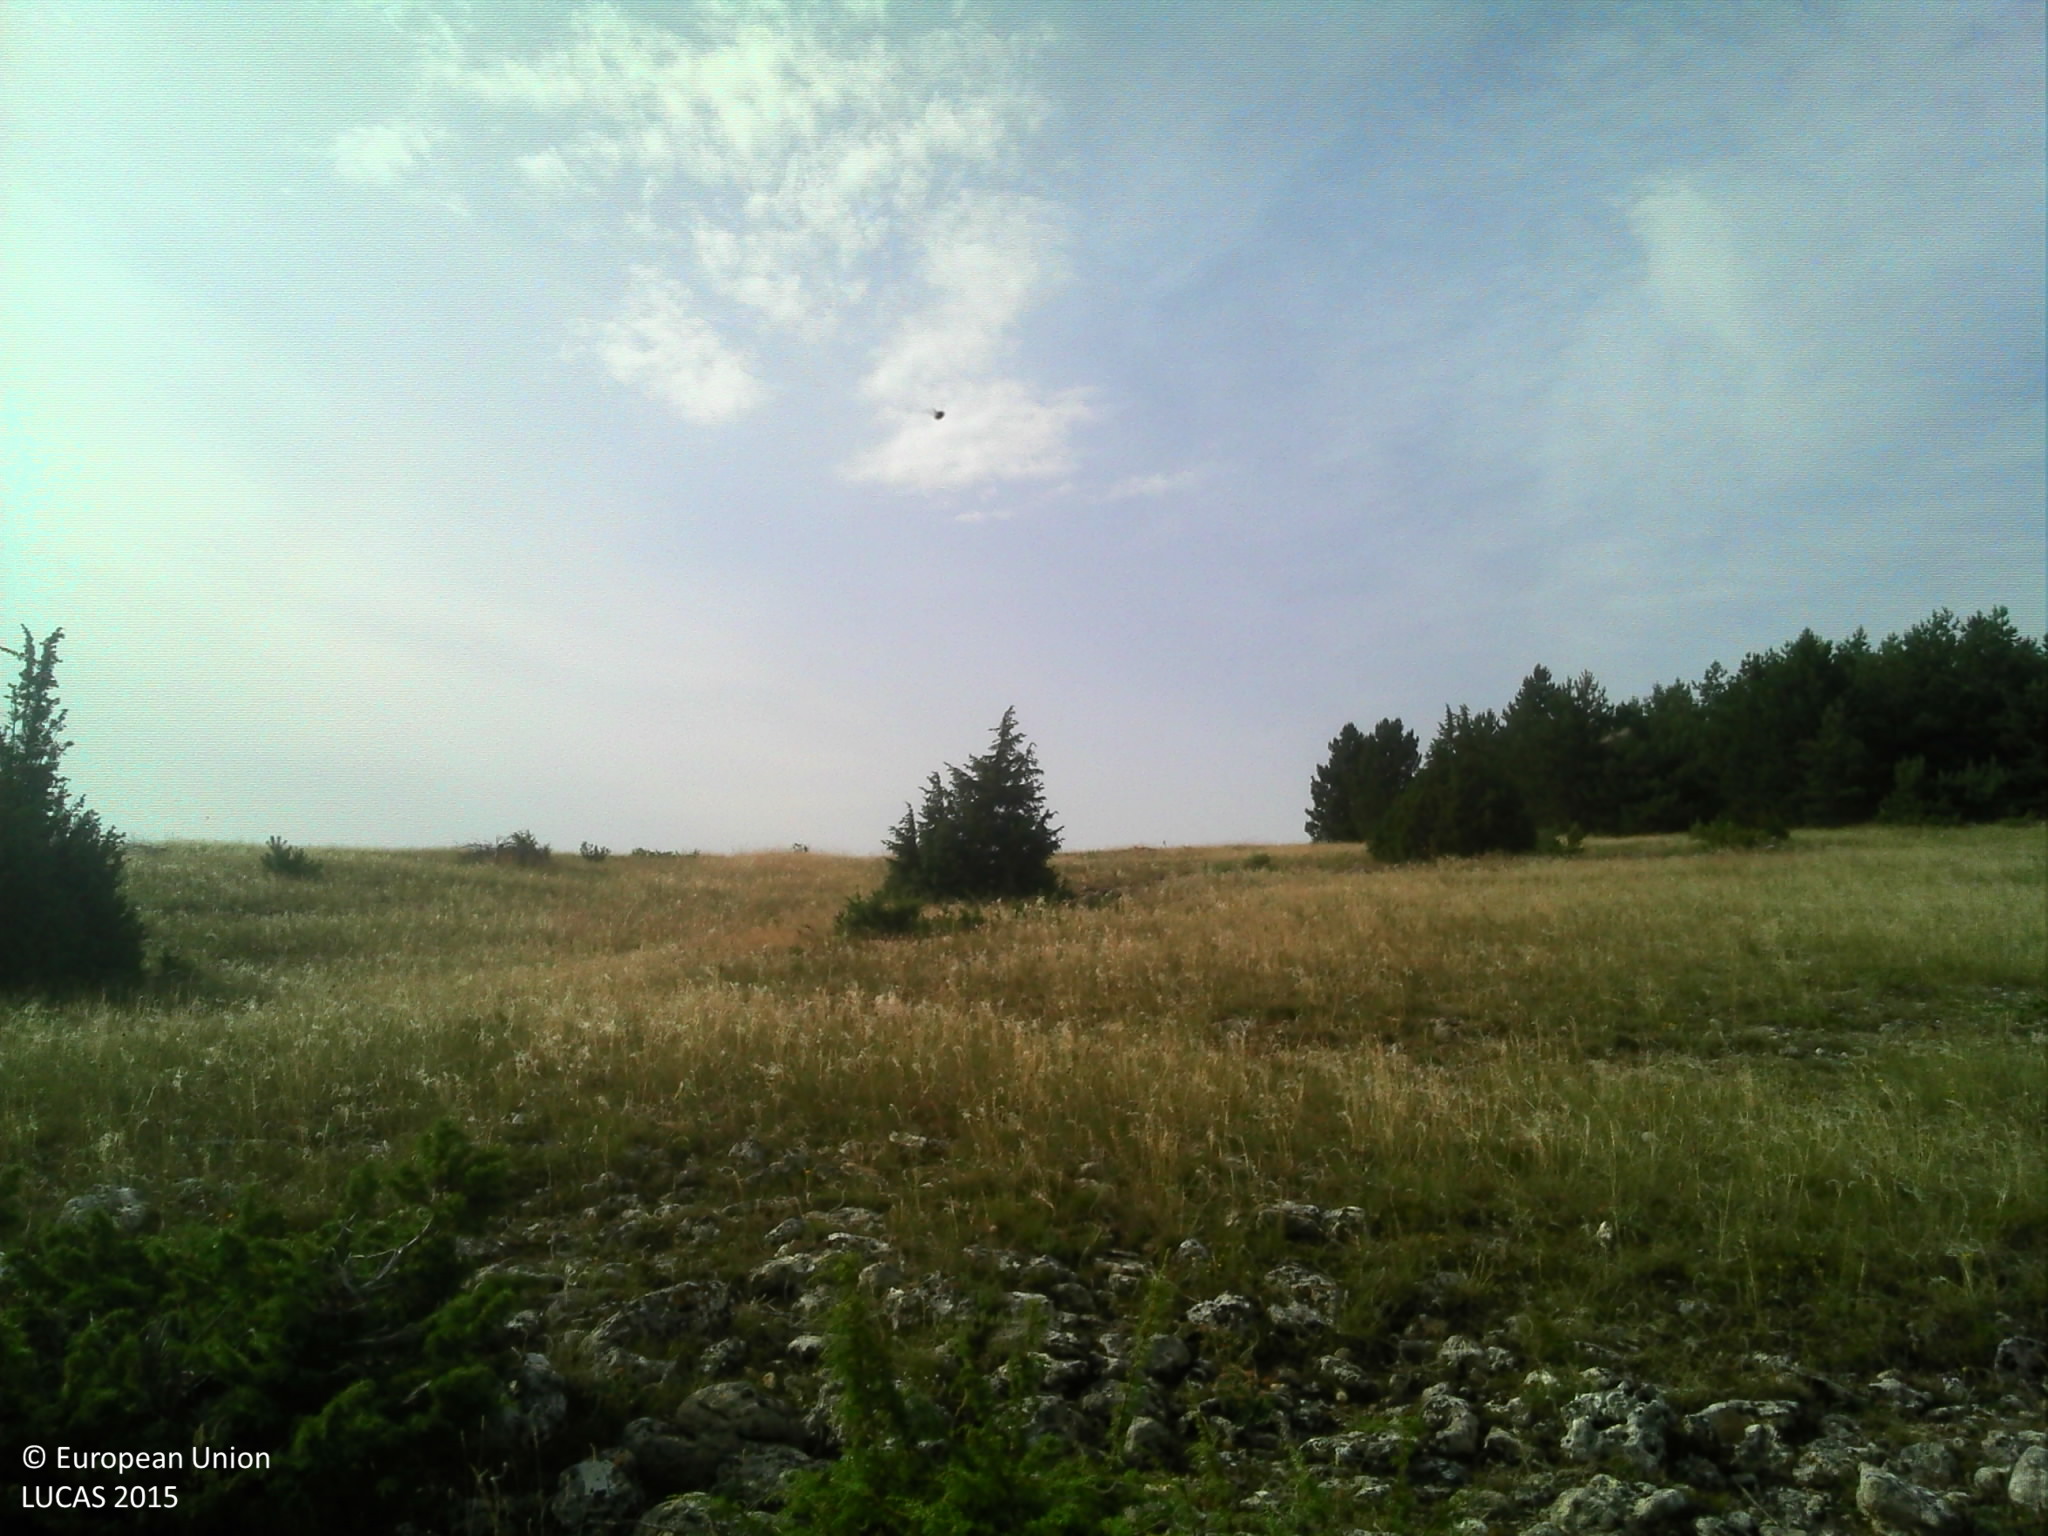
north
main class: Grassland
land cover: Grassland with sparse tree/shrub cover
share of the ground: > 75 %
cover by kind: herbaceous plants 80 %, coniferous forest trees 5 %, shrubs 5 %, unconsolidated bare surface 5 %
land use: Agriculture (excluding fallow land and kitchen gardens)
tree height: < 5 m
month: July
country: FR
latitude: 44.2899
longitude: 3.4768
